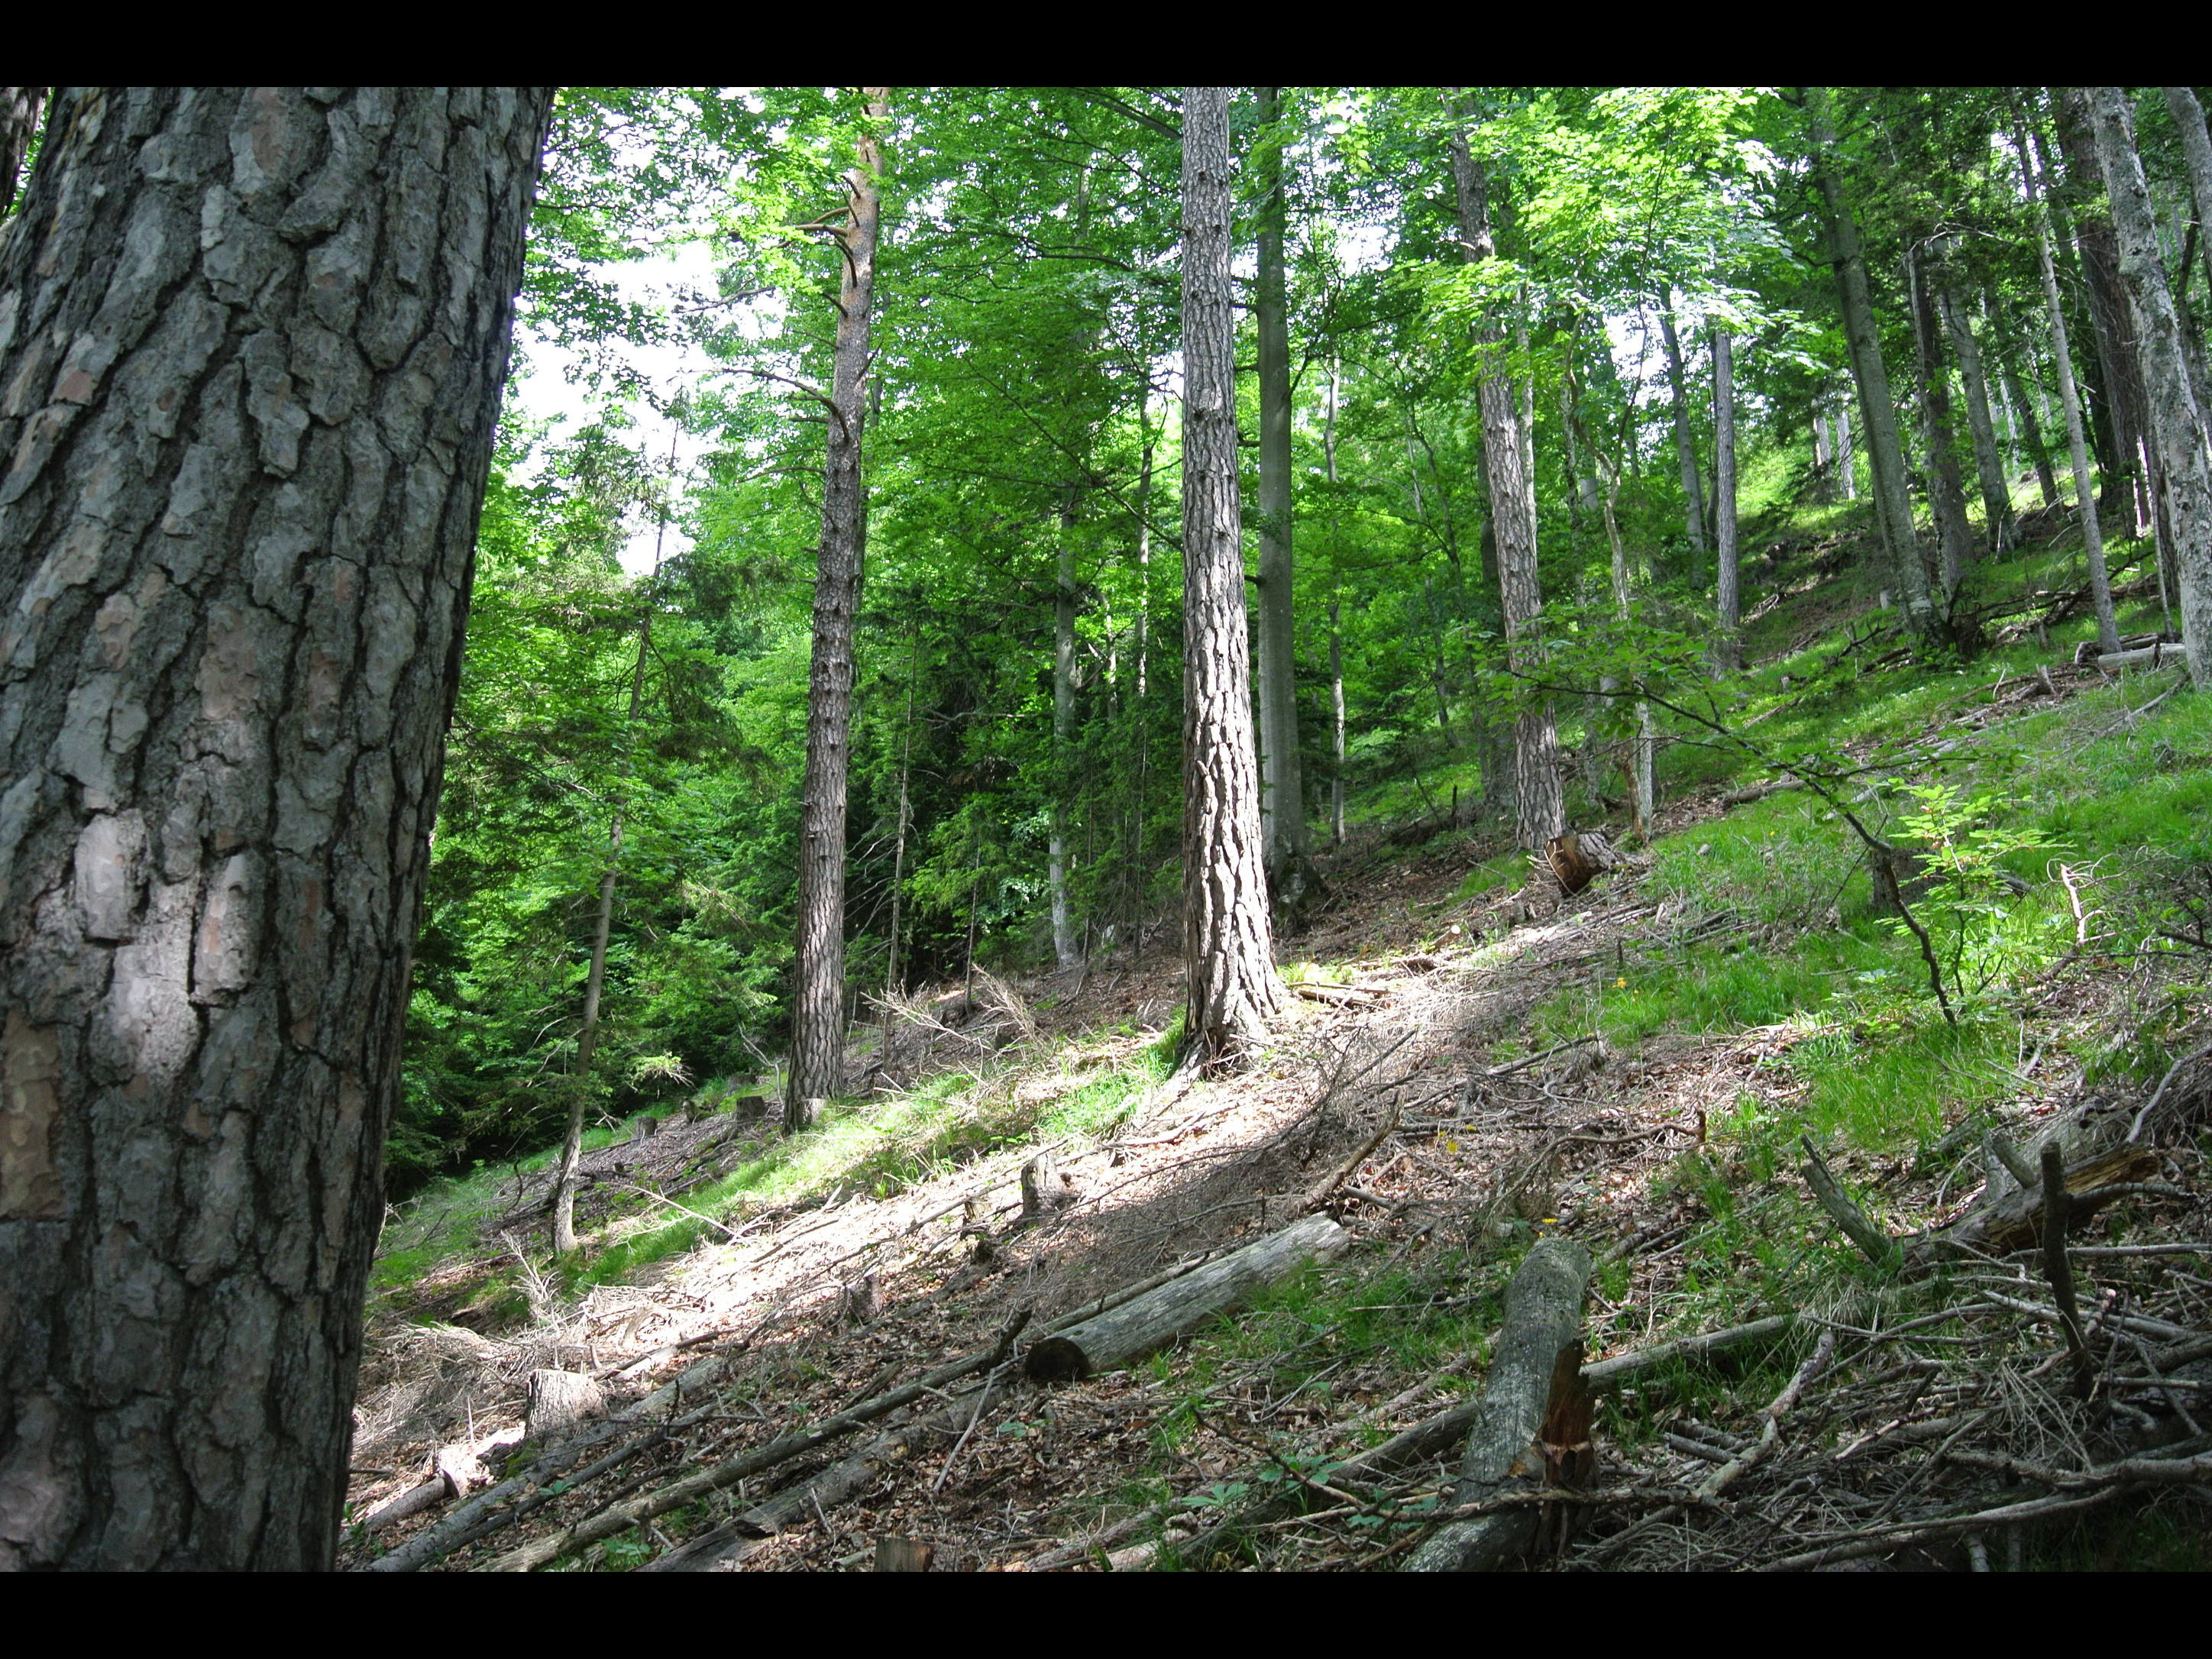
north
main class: Woodland
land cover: Other mixed woodland
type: alpine coniferous forest
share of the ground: > 75 %
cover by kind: broadleaved forest trees 70 %, coniferous forest trees 30 %
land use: Forestry
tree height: > 5 m
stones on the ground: < 10 %
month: June
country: AT
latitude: 47.9115
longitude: 15.7423
